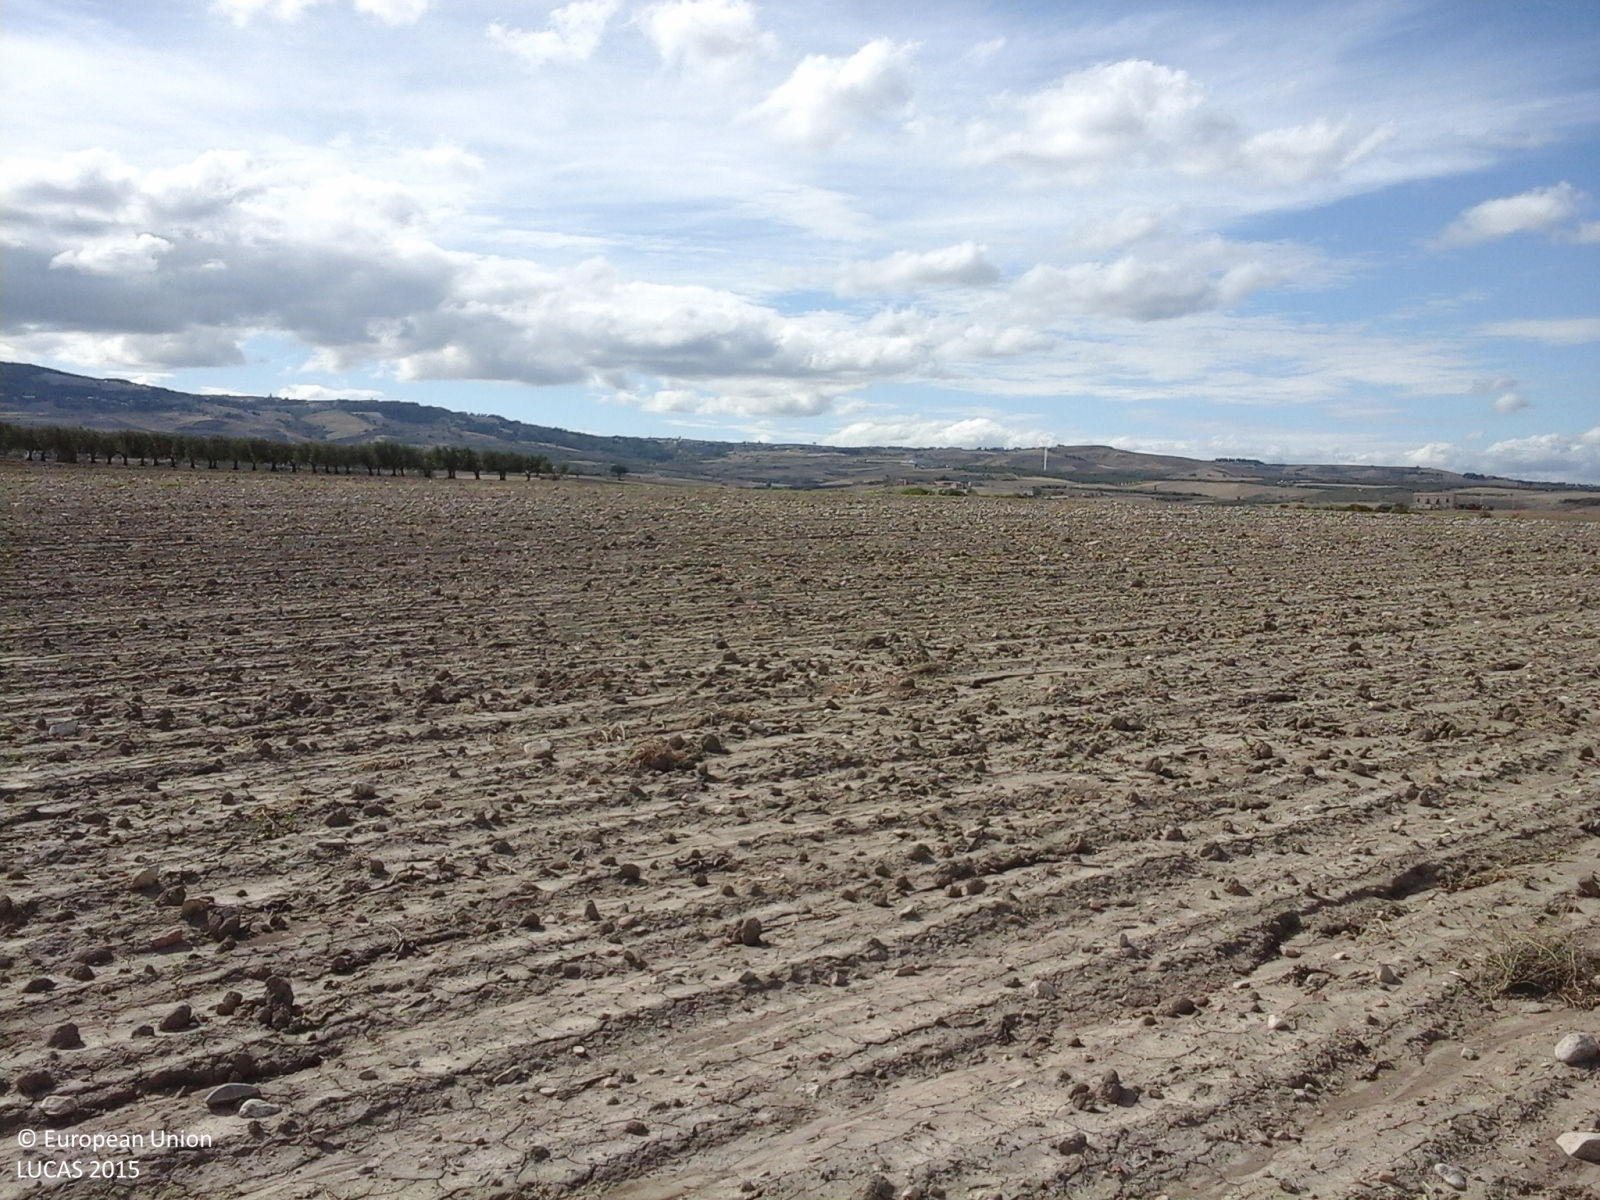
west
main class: Cropland
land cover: Dry pulses
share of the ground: > 75 %
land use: Agriculture (excluding fallow land and kitchen gardens)
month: September
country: IT
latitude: 41.5984
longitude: 15.1780
